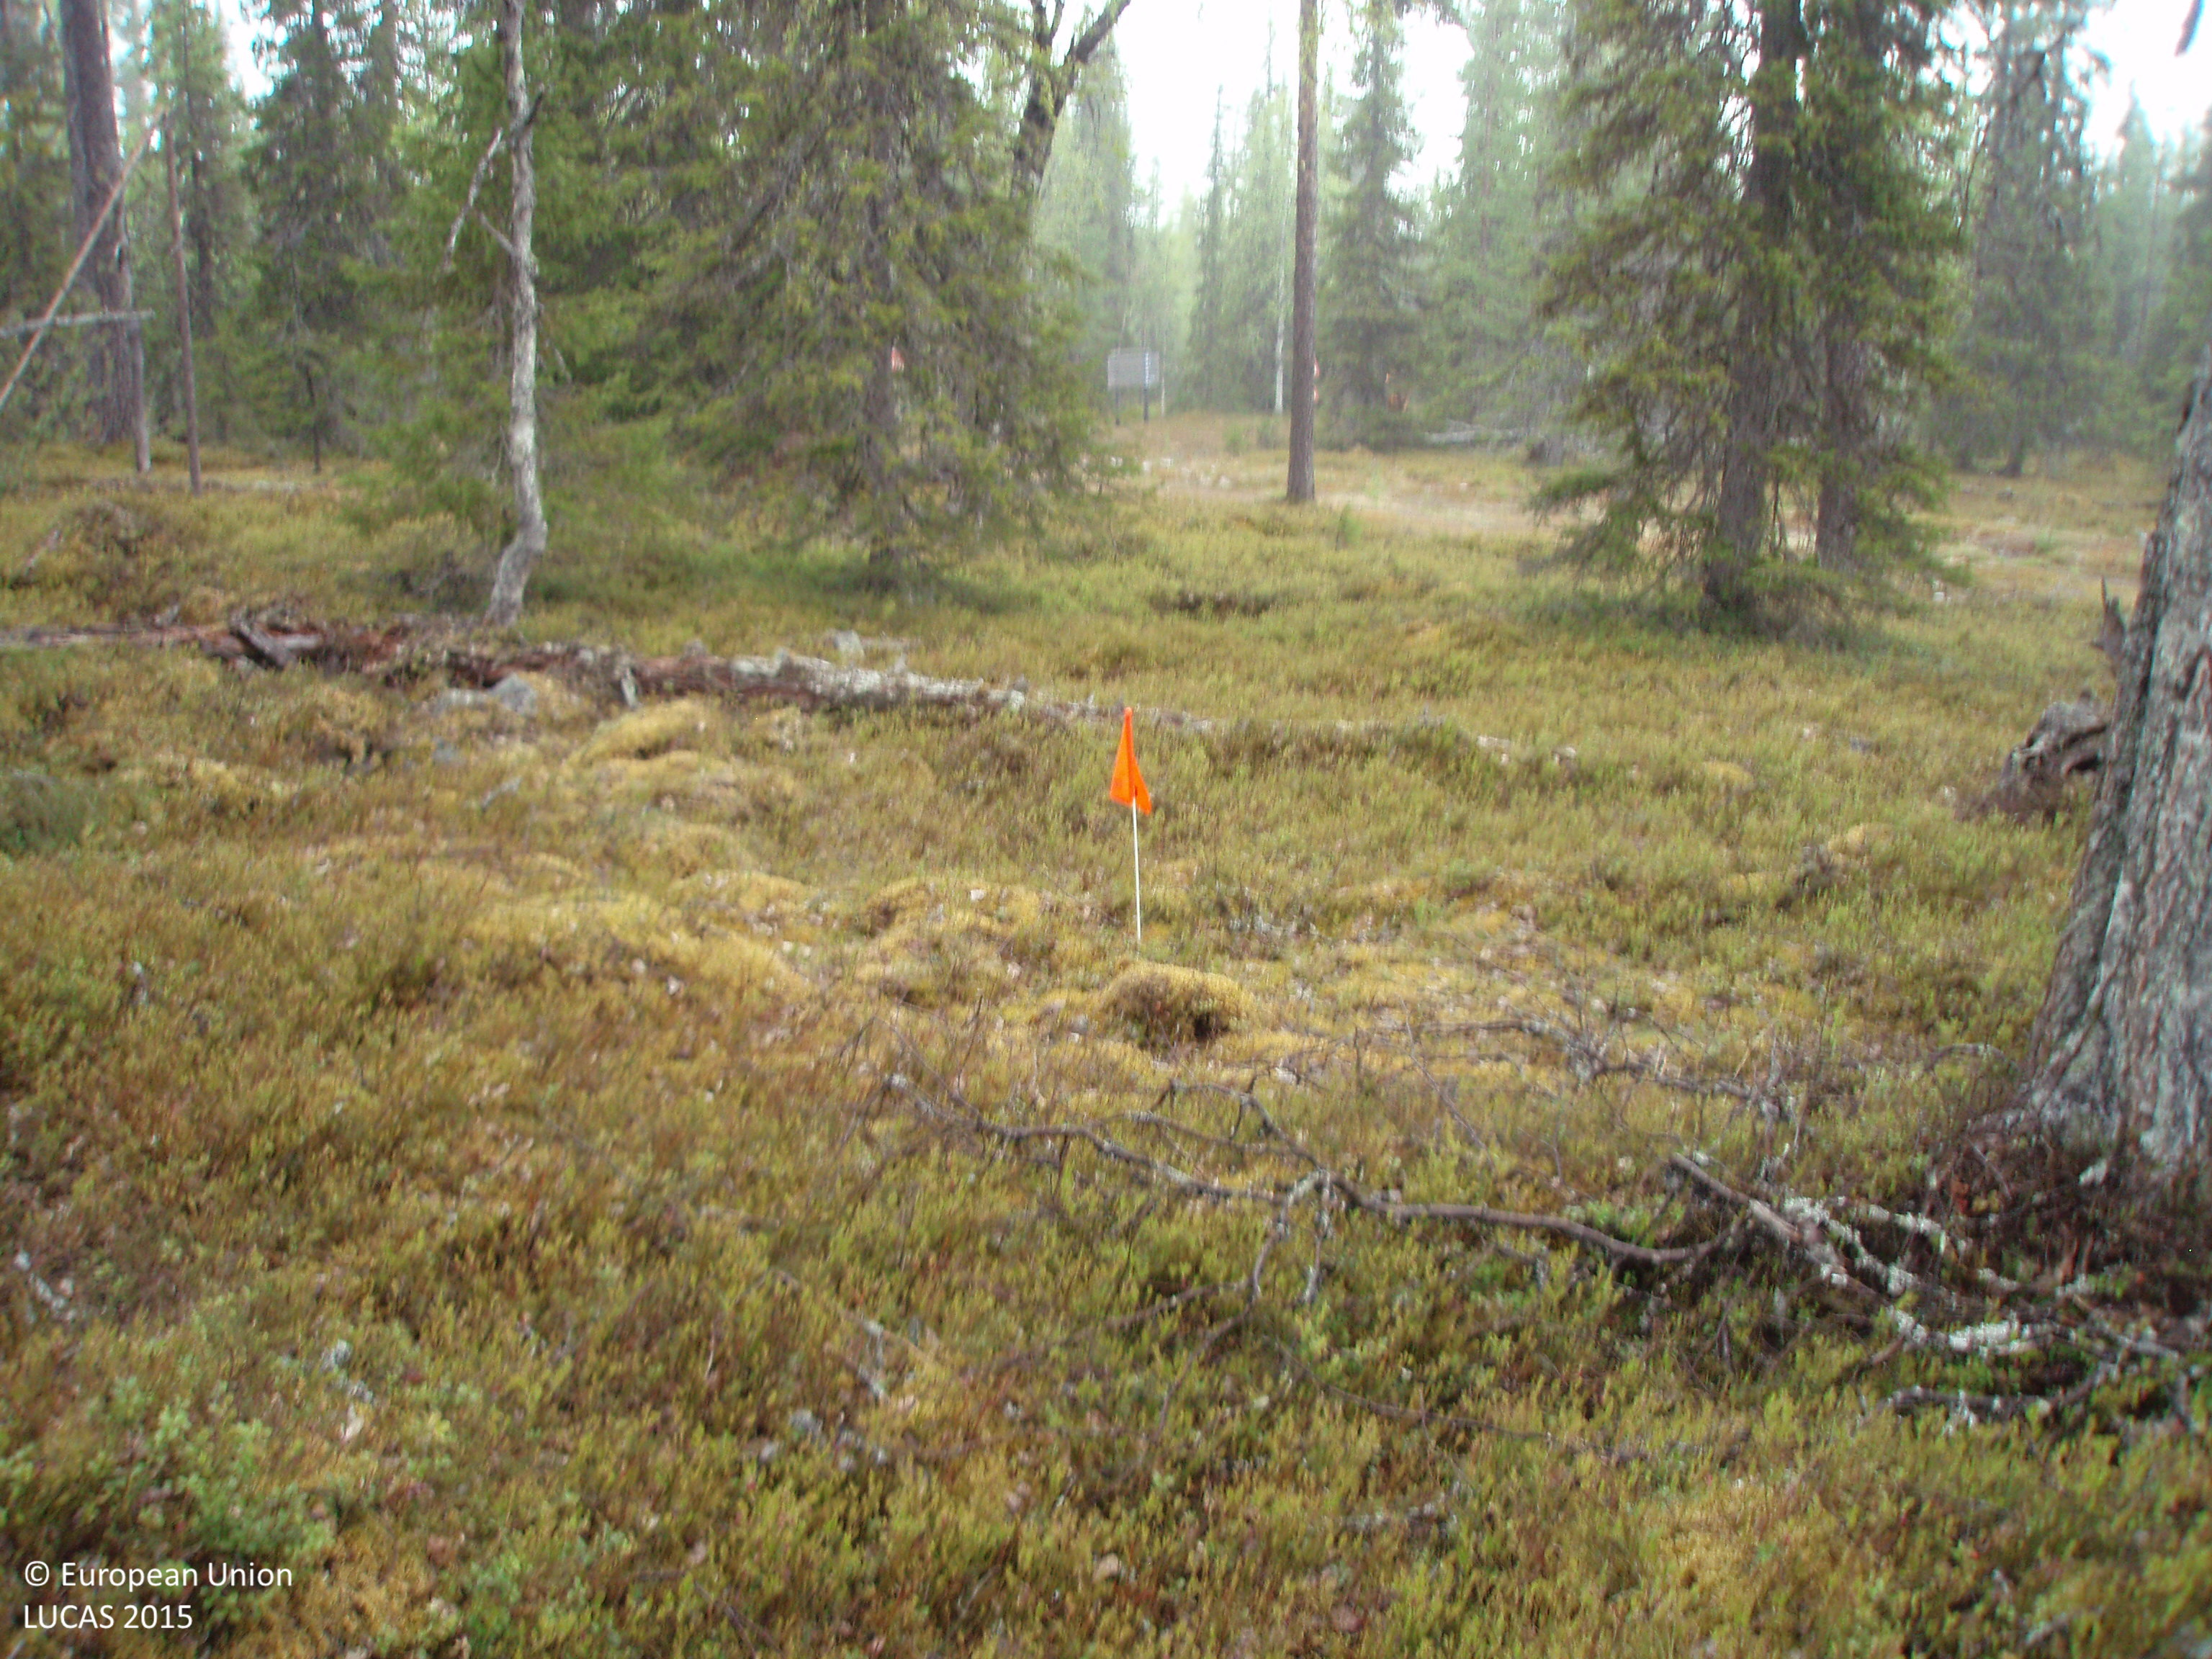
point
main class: Woodland
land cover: Other mixed woodland
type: boreal forest
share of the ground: 50 - 75 %
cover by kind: coniferous forest trees 40 %, shrubs 30 %, broadleaved forest trees 15 %, lichens and mosses 15 %
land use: Forestry
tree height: > 5 m
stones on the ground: < 10 %
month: June
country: FI
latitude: 67.1197
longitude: 26.9840
